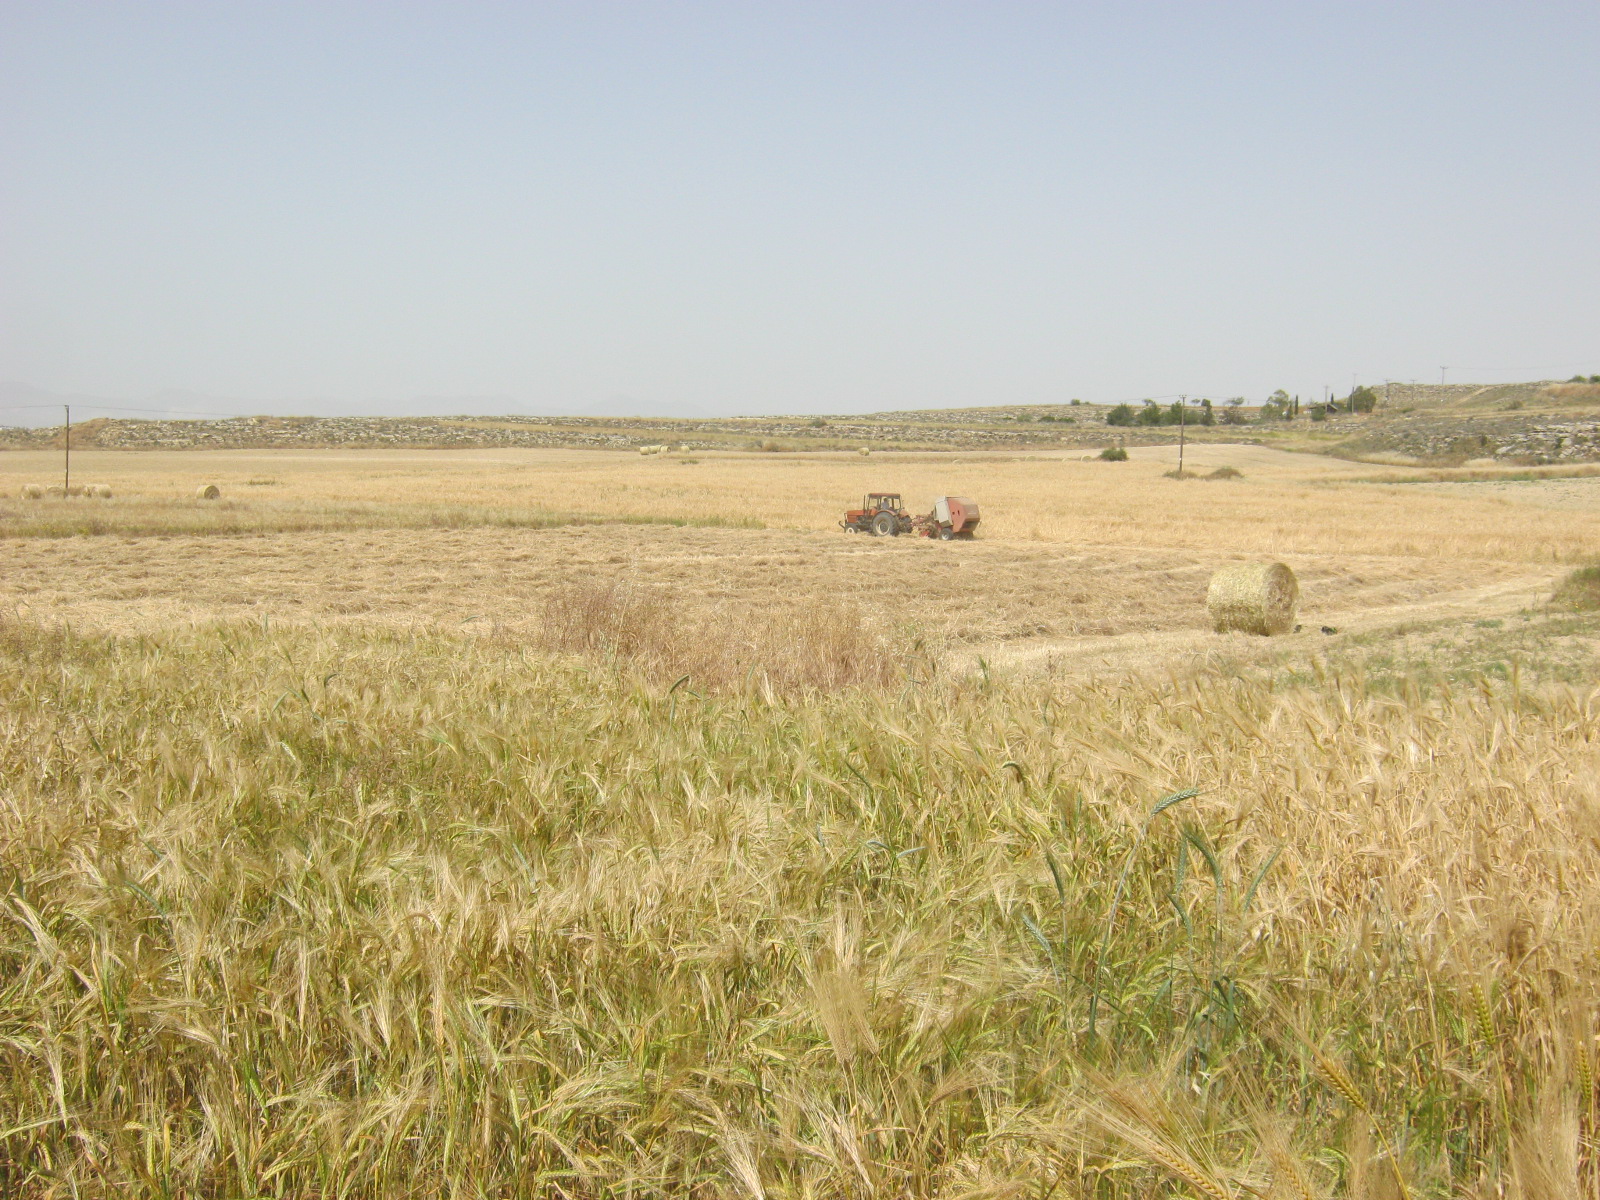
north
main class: Cropland
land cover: Barley
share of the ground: > 75 %
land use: Agriculture (excluding fallow land and kitchen gardens)
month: April
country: CY
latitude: 35.0819
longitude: 33.4117
